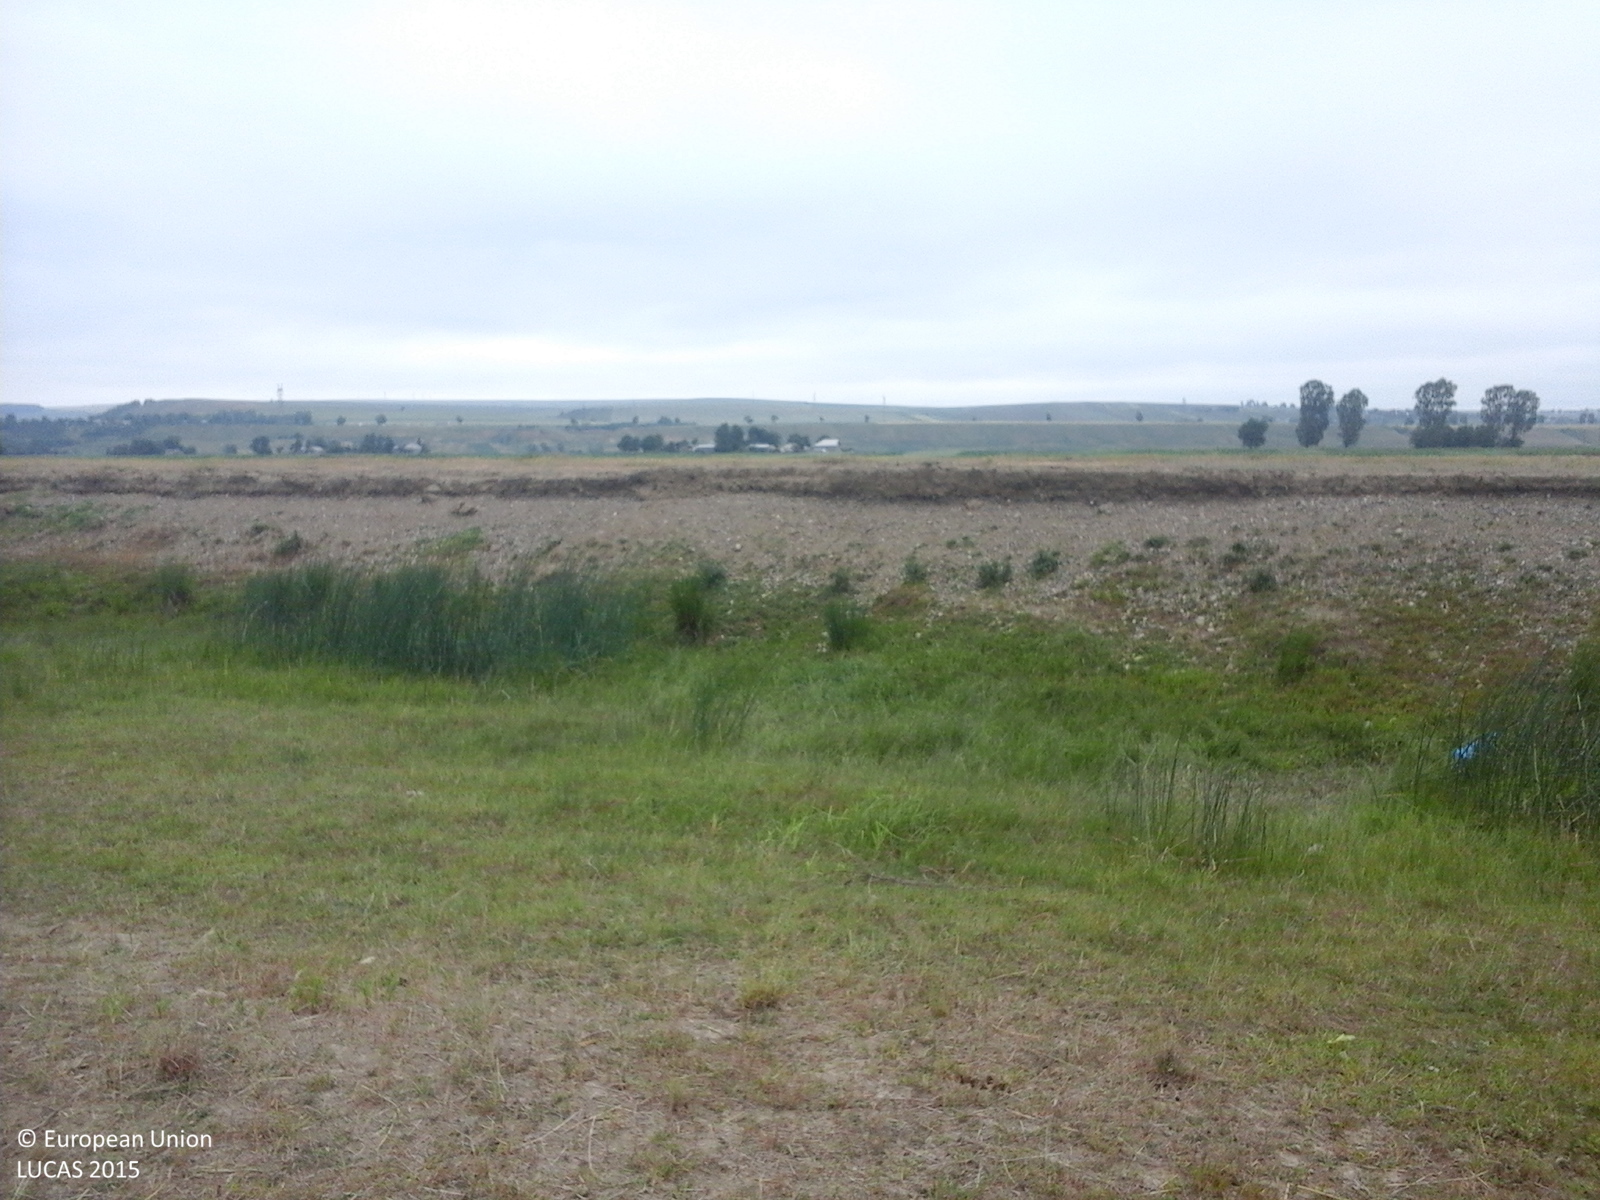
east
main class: Grassland
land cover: Grassland without tree/shrub cover
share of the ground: 25 - 50 %
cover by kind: herbaceous plants 100 %
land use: Agriculture (excluding fallow land and kitchen gardens)
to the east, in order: Grassland without tree/shrub cover; Inland marshes; Grassland without tree/shrub cover; Tracks; Grassland without tree/shrub cover; Tracks; Grassland without tree/shrub cover; Maize
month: June
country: RO
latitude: 47.1314
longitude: 26.6354
